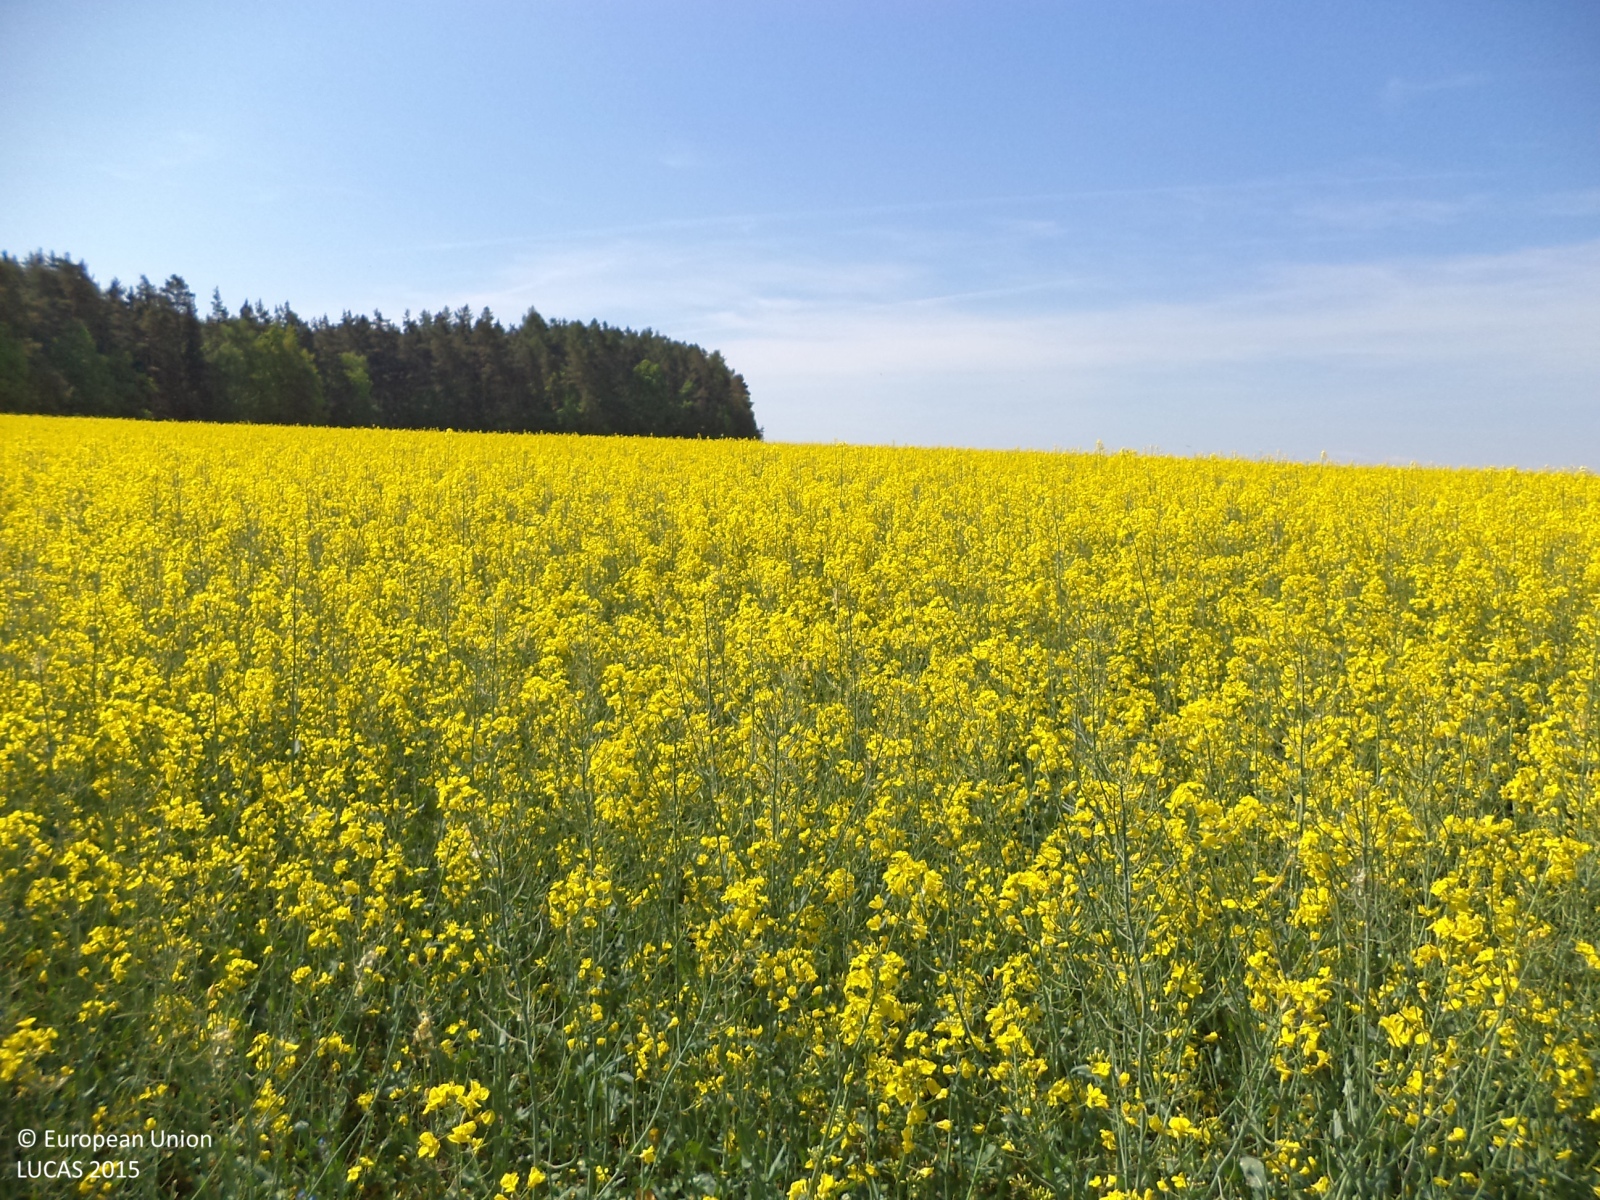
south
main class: Cropland
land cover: Rape and turnip rape
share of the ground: > 75 %
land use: Agriculture (excluding fallow land and kitchen gardens)
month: May
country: CZ
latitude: 49.2499
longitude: 14.9065
